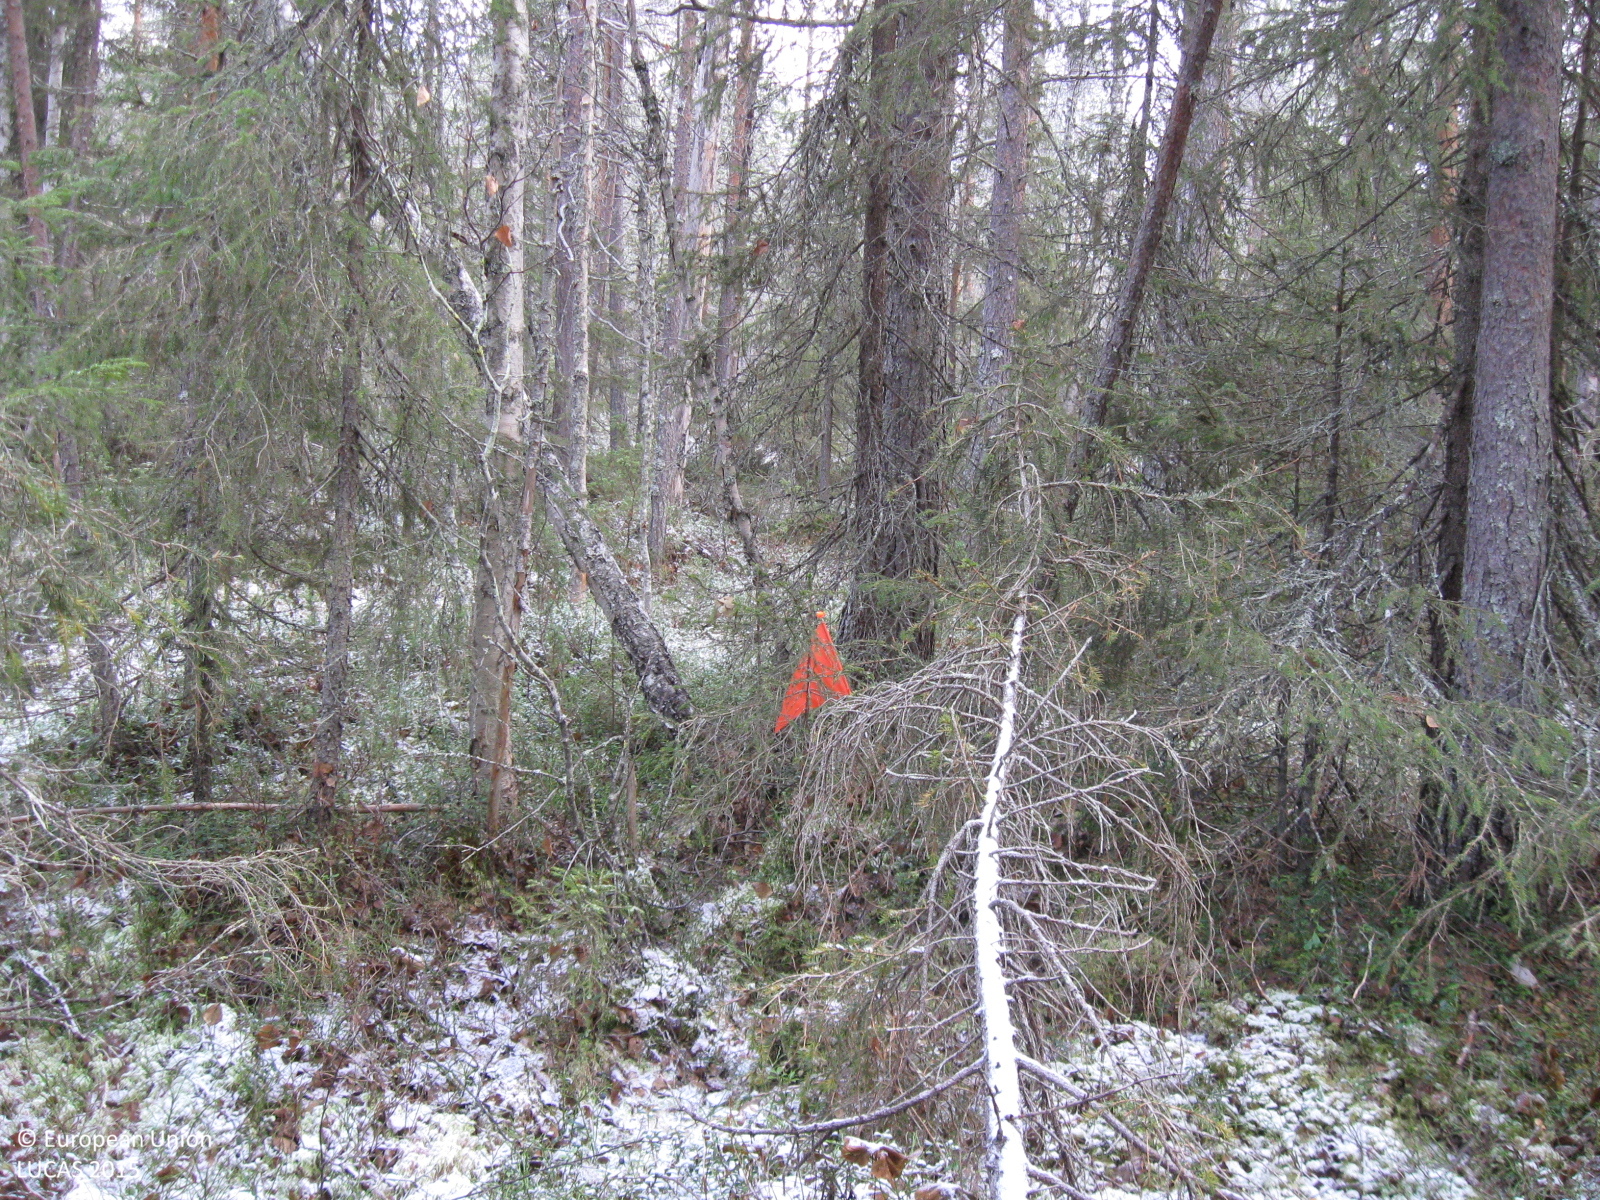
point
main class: Woodland
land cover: Other coniferous woodland
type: mire and swamp forests
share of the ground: > 75 %
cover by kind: coniferous forest trees 75 %, broadleaved forest trees 10 %, shrubs 5 %, herbaceous plants 5 %, lichens and mosses 5 %
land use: Forestry
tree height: > 5 m
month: October
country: SE
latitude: 66.1383
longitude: 21.2409
